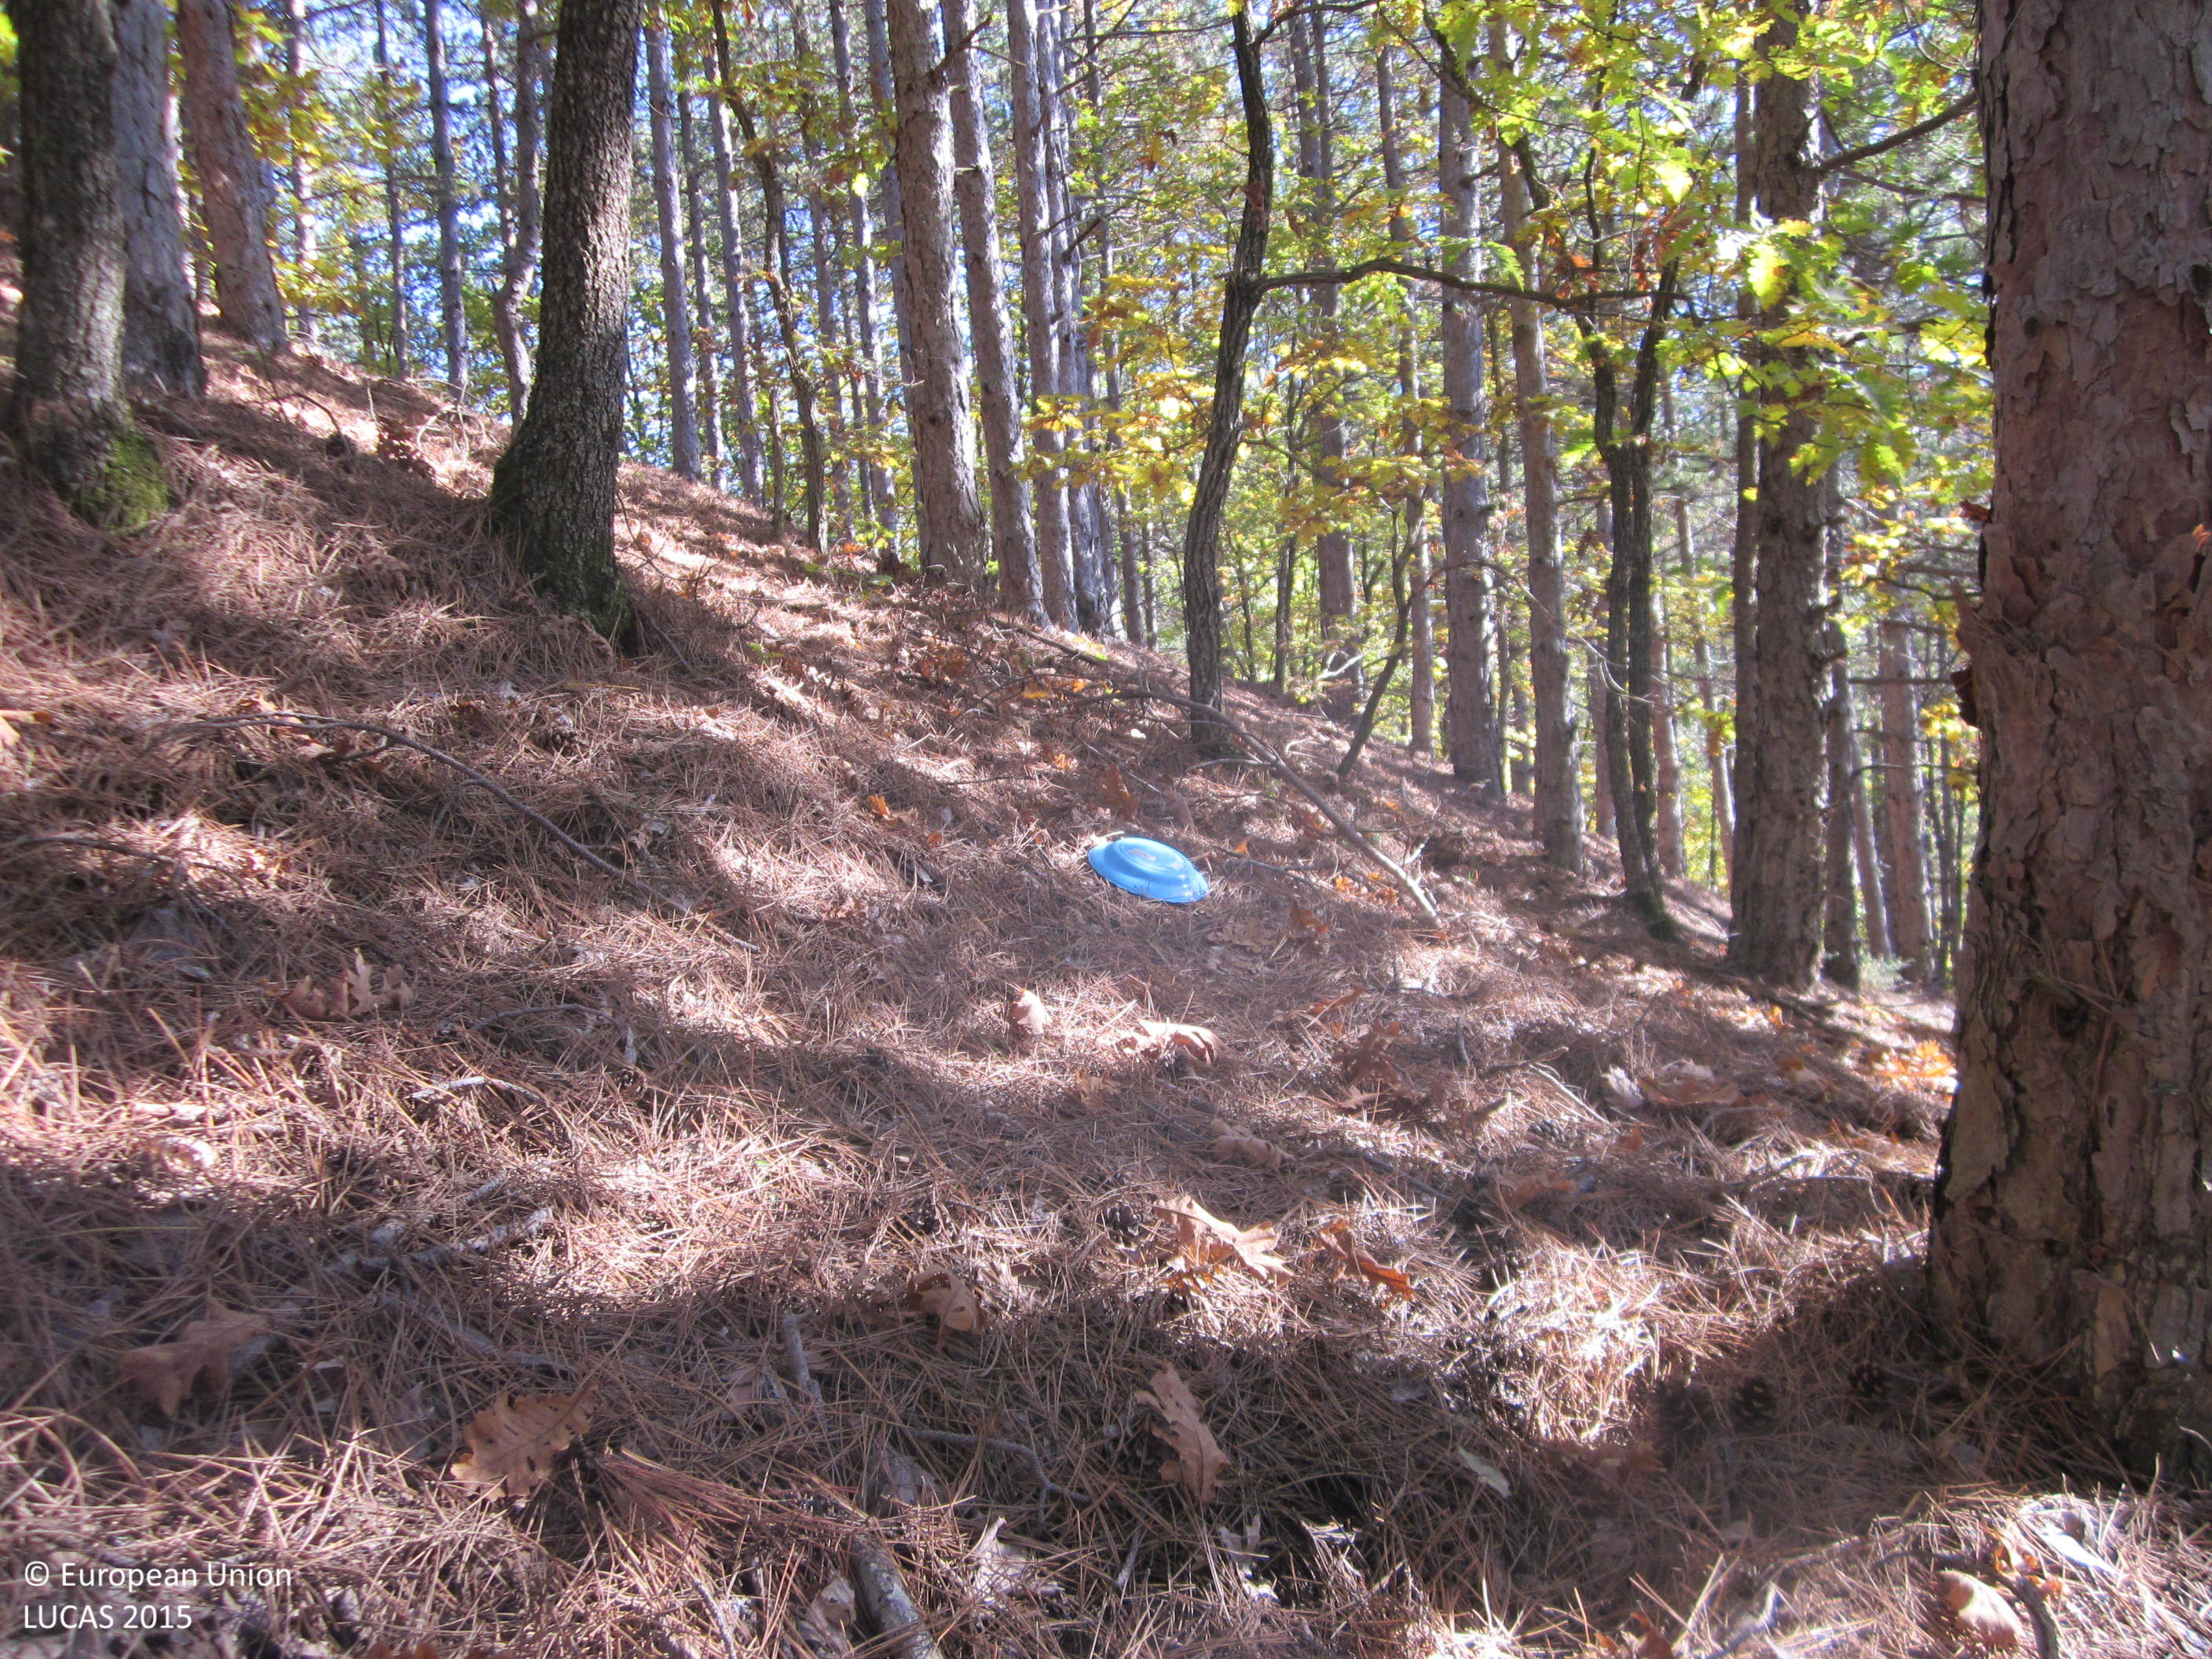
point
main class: Woodland
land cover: Pine dominated coniferous woodland
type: hemiboreal forest and nemoral coniferous forest and mixed broadleaved-coniferous forest
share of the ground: > 75 %
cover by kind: coniferous forest trees 70 %, unconsolidated bare surface 20 %, broadleaved forest trees 10 %
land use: Forestry
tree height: > 5 m
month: November
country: BG
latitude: 41.4664
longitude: 25.7593
